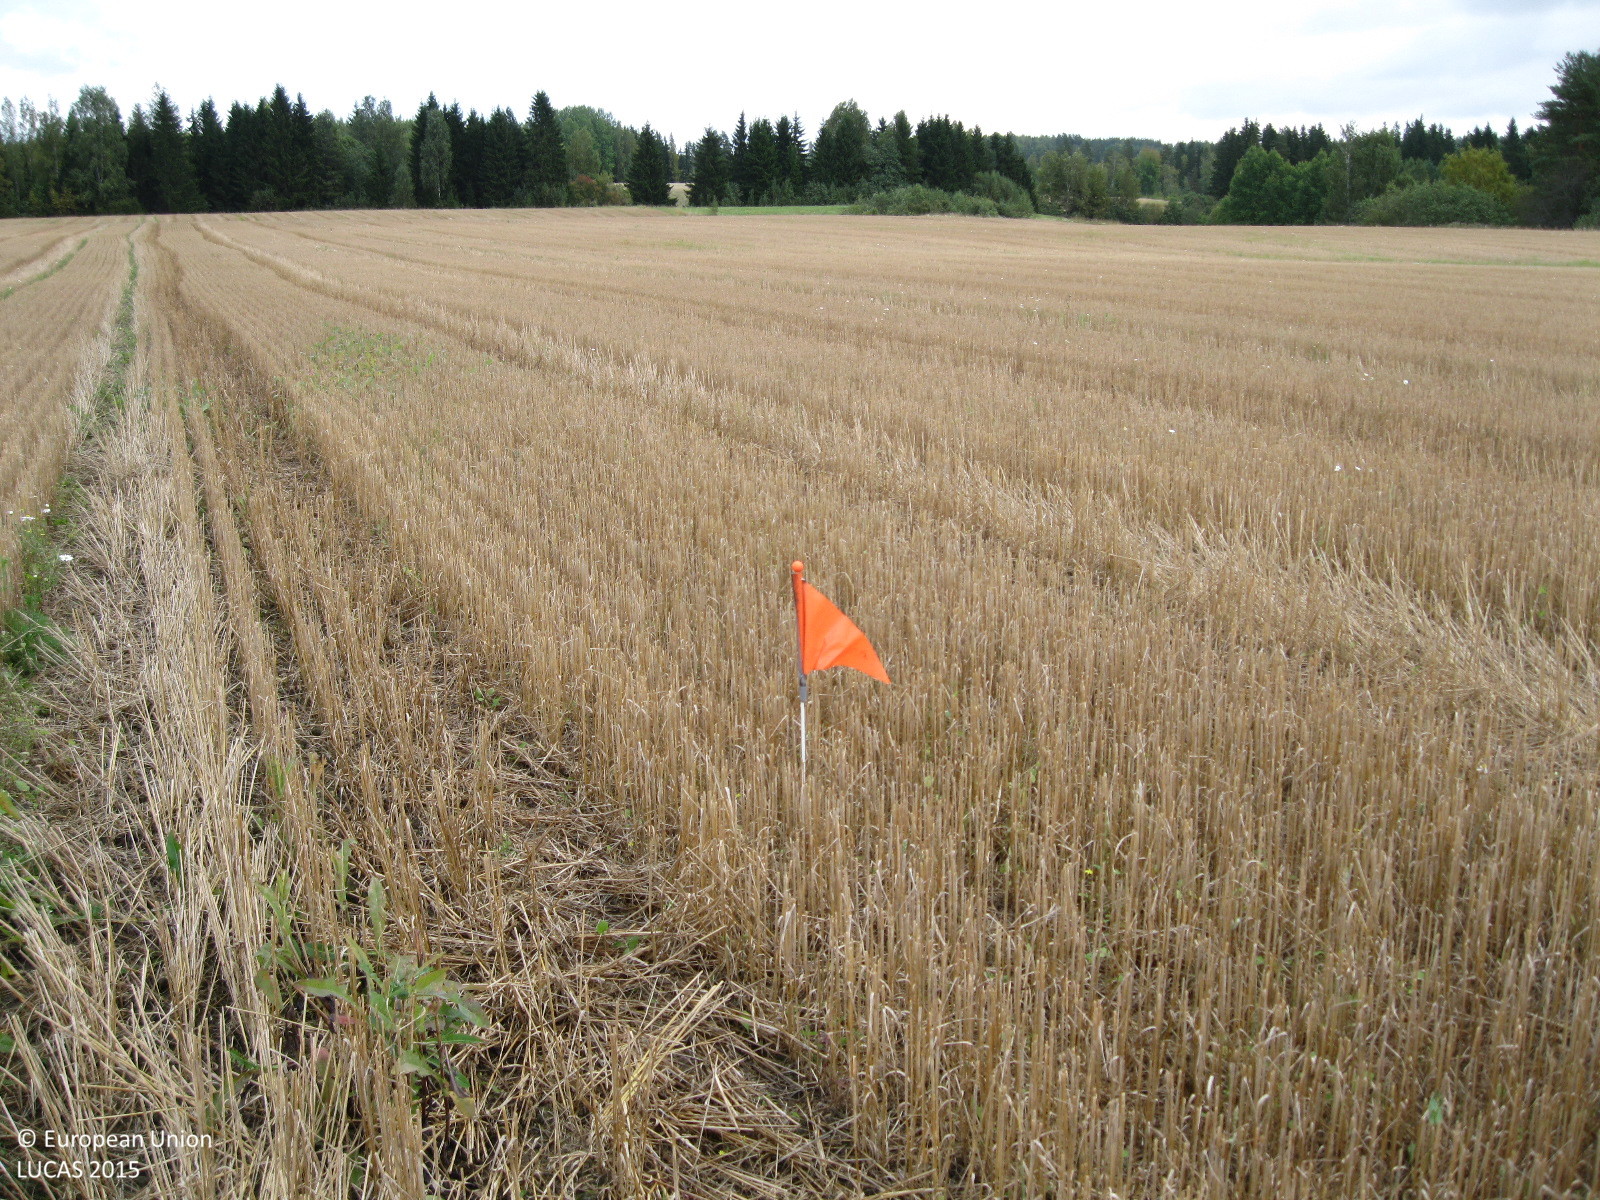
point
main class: Cropland
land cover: Common wheat
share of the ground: > 75 %
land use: Agriculture (excluding fallow land and kitchen gardens)
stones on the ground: < 10 %
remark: Harvested field
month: September
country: FI
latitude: 60.4353
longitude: 24.8498
